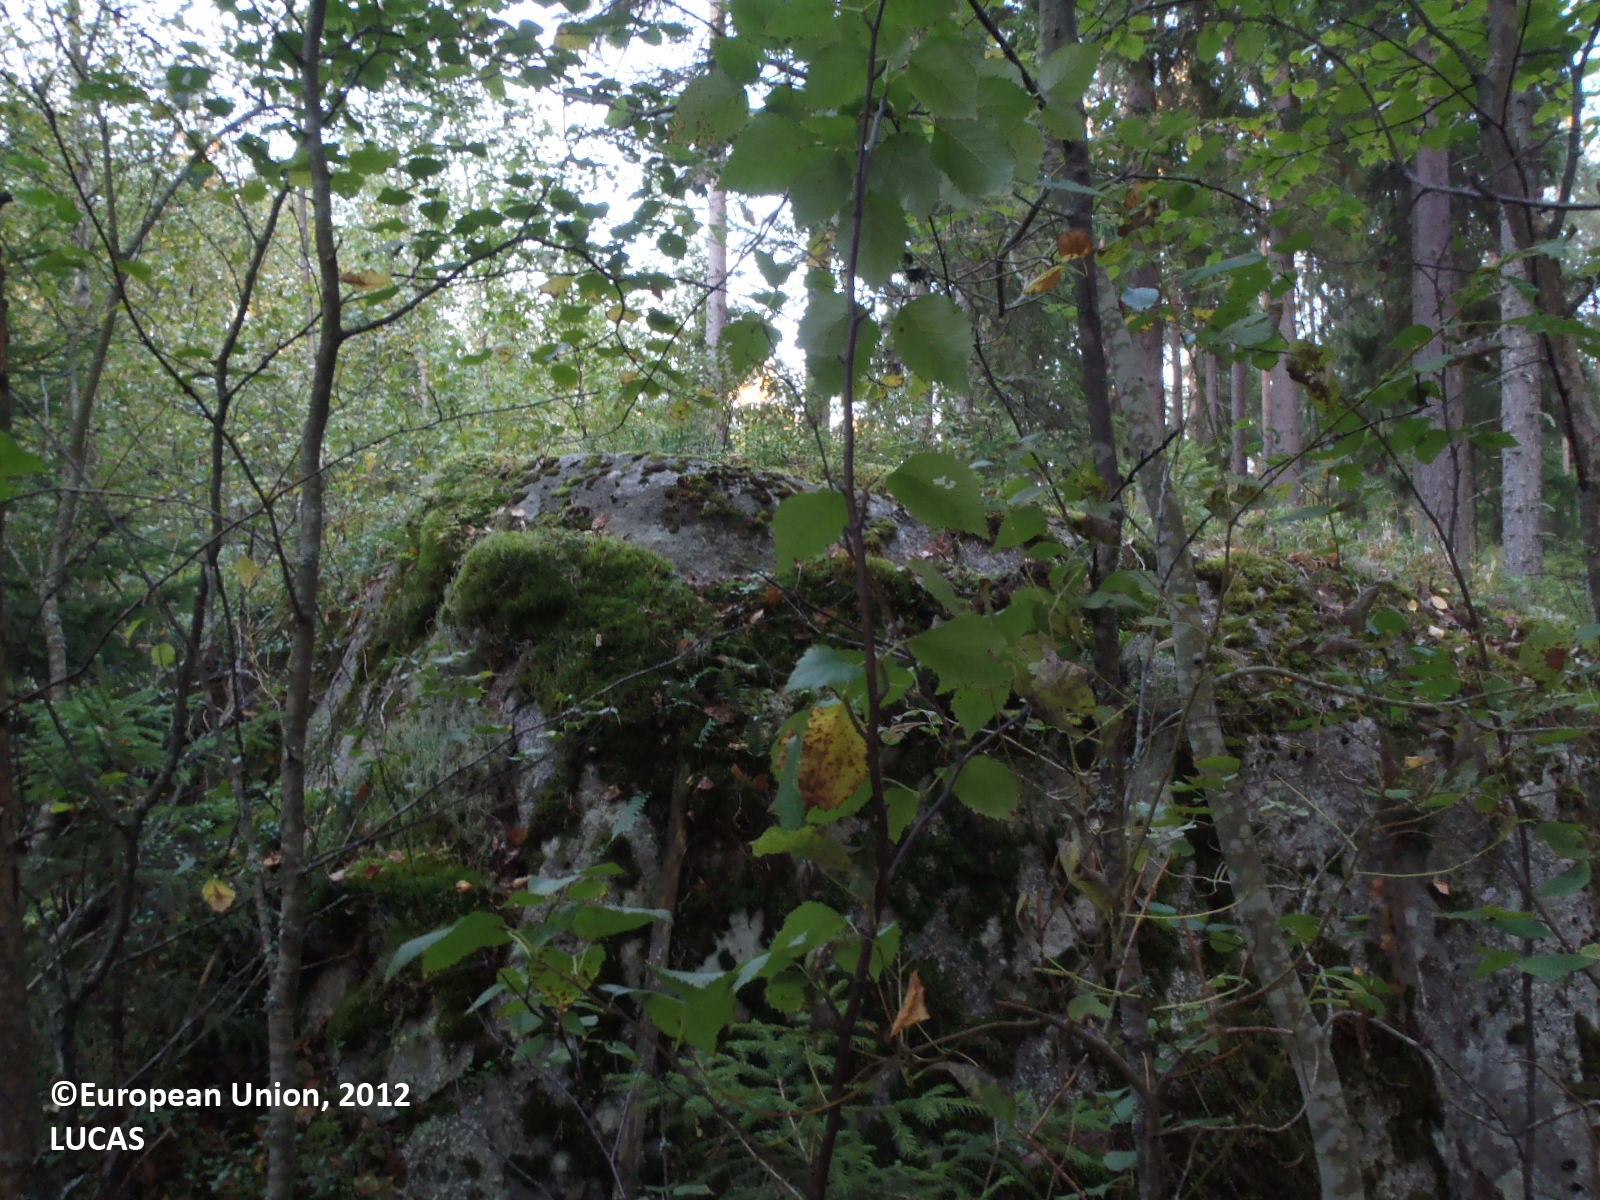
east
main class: Woodland
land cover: Pine dominated mixed woodland
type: boreal forest
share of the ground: > 75 %
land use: Forestry
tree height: > 5 m
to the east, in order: Pine dominated mixed woodland; Pine dominated coniferous woodland
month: September
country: FI
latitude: 61.3270
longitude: 22.6405
